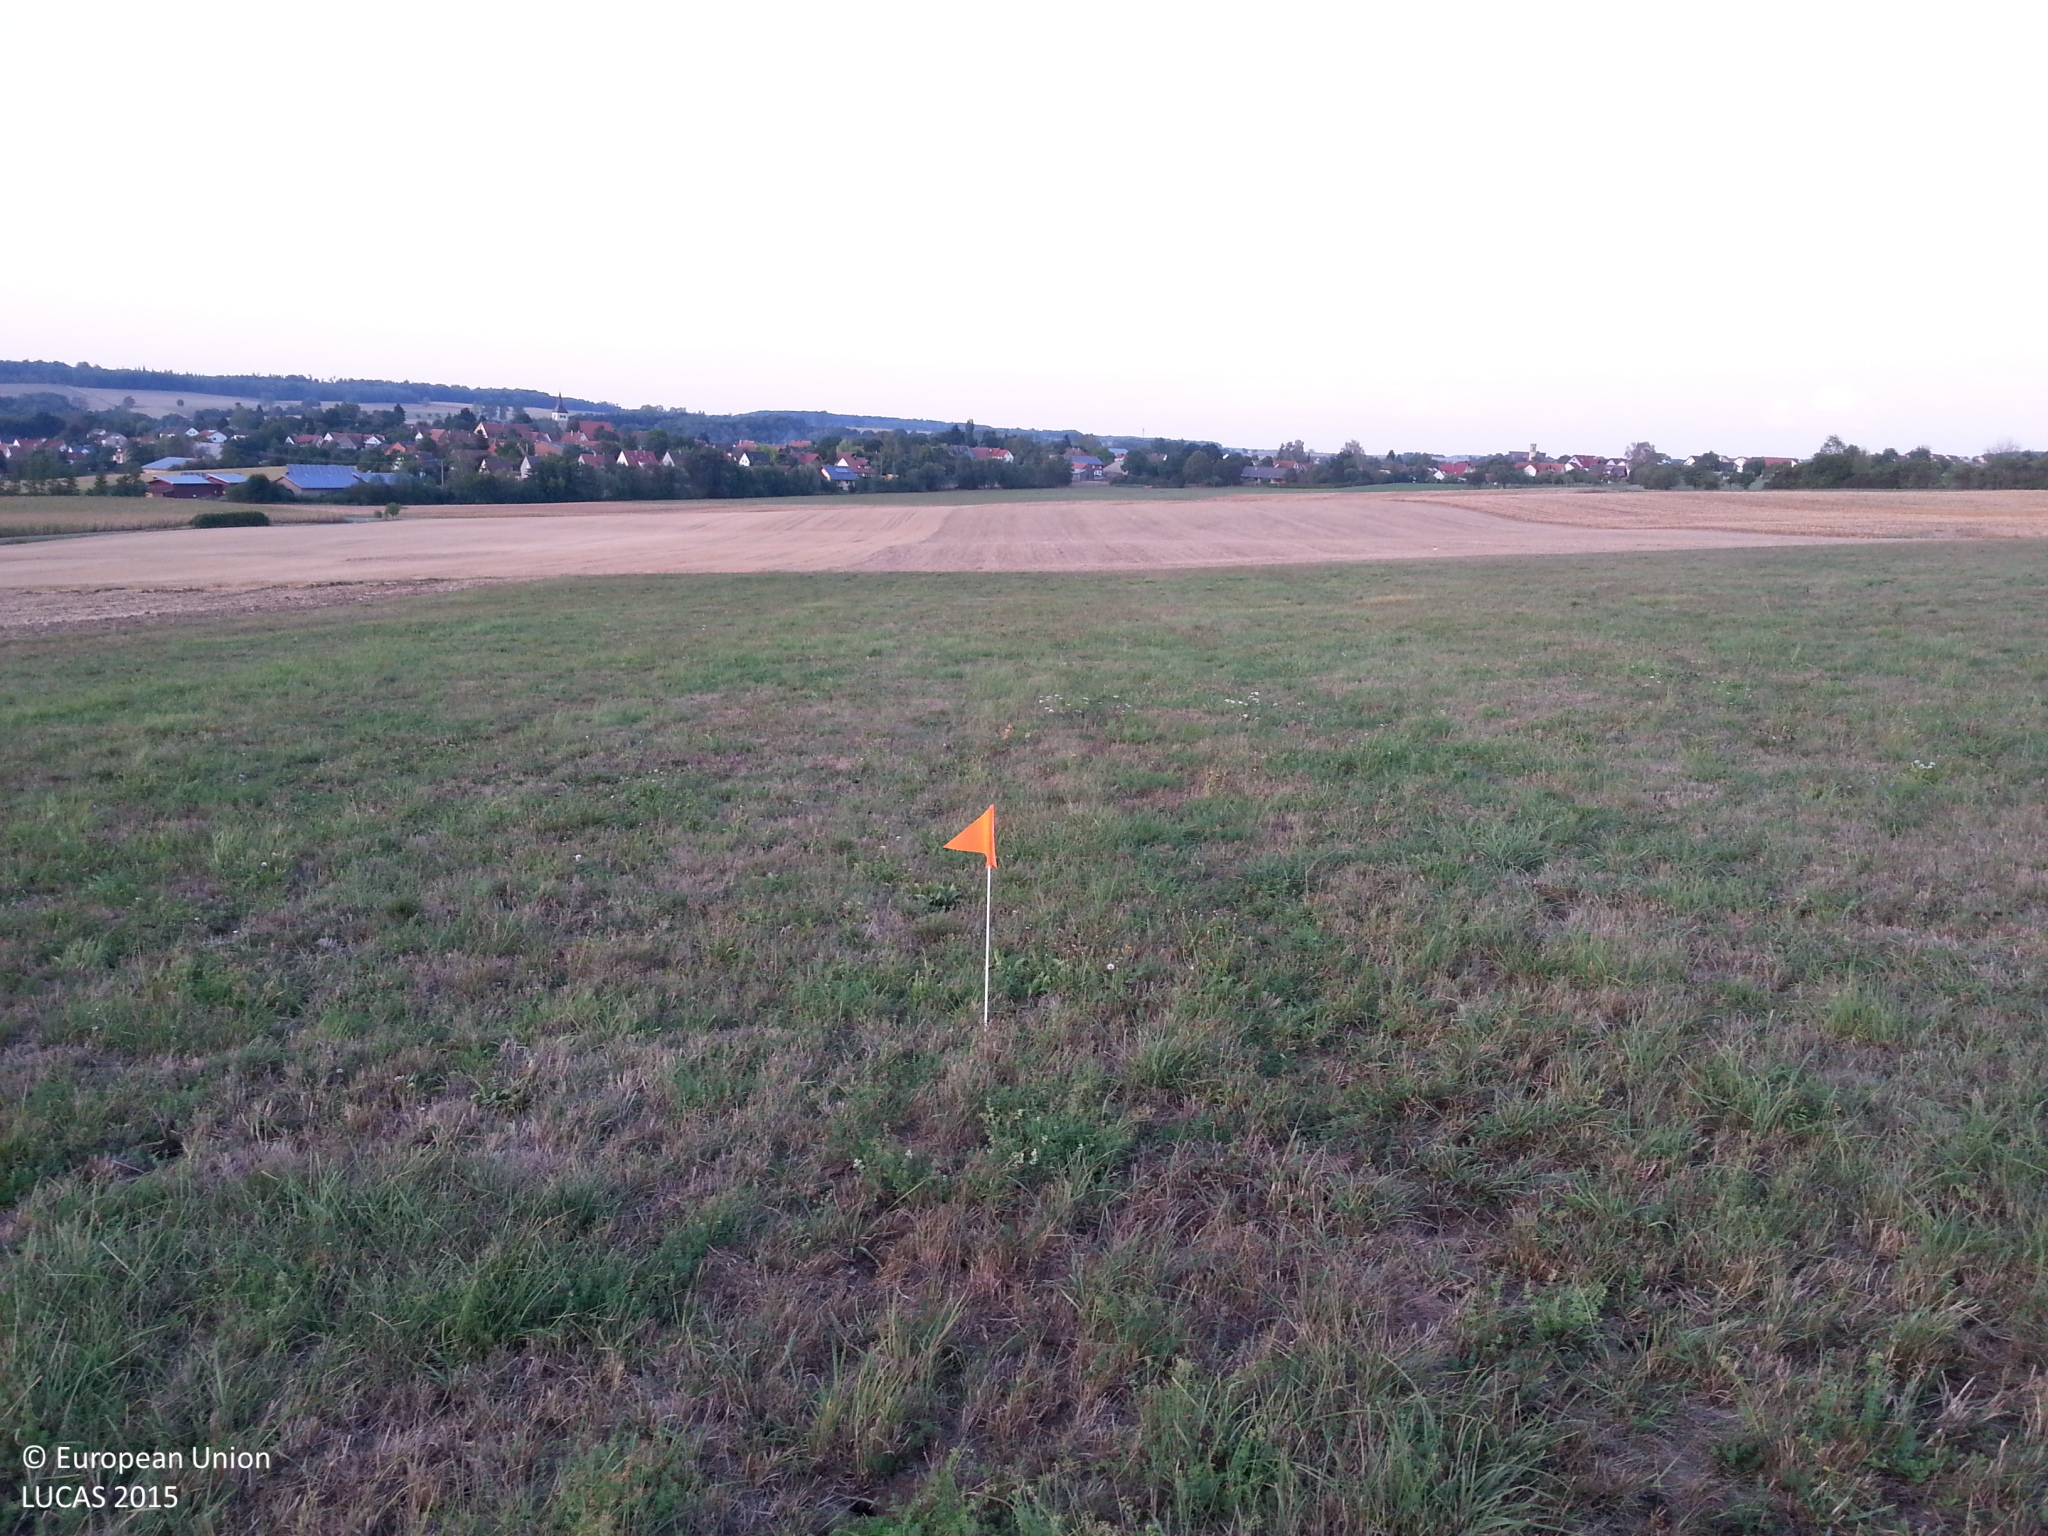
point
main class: Grassland
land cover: Grassland without tree/shrub cover
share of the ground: > 75 %
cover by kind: herbaceous plants 100 %
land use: Agriculture (excluding fallow land and kitchen gardens)
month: August
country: DE
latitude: 49.1951
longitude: 9.9588
